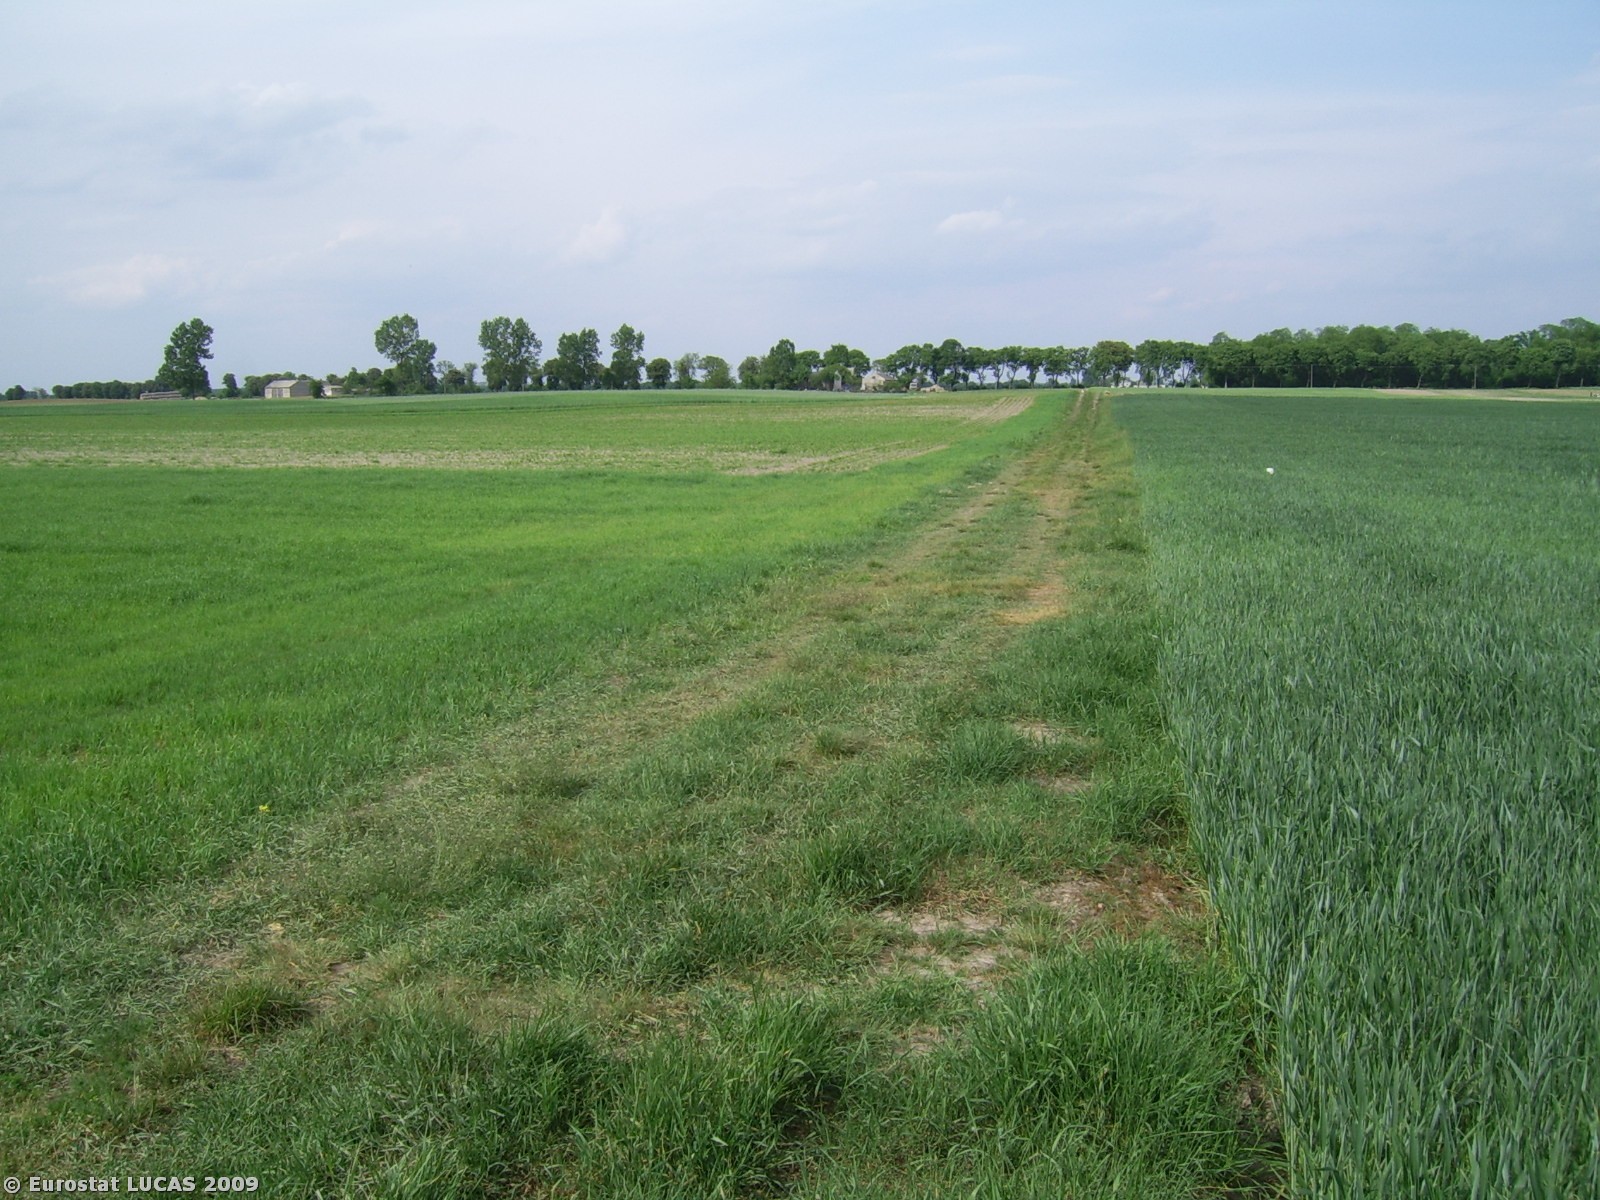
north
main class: Cropland
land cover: Common wheat
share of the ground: > 75 %
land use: Agriculture (excluding fallow land and kitchen gardens)
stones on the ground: < 10 %
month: May
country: PL
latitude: 52.7595
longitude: 17.9726
